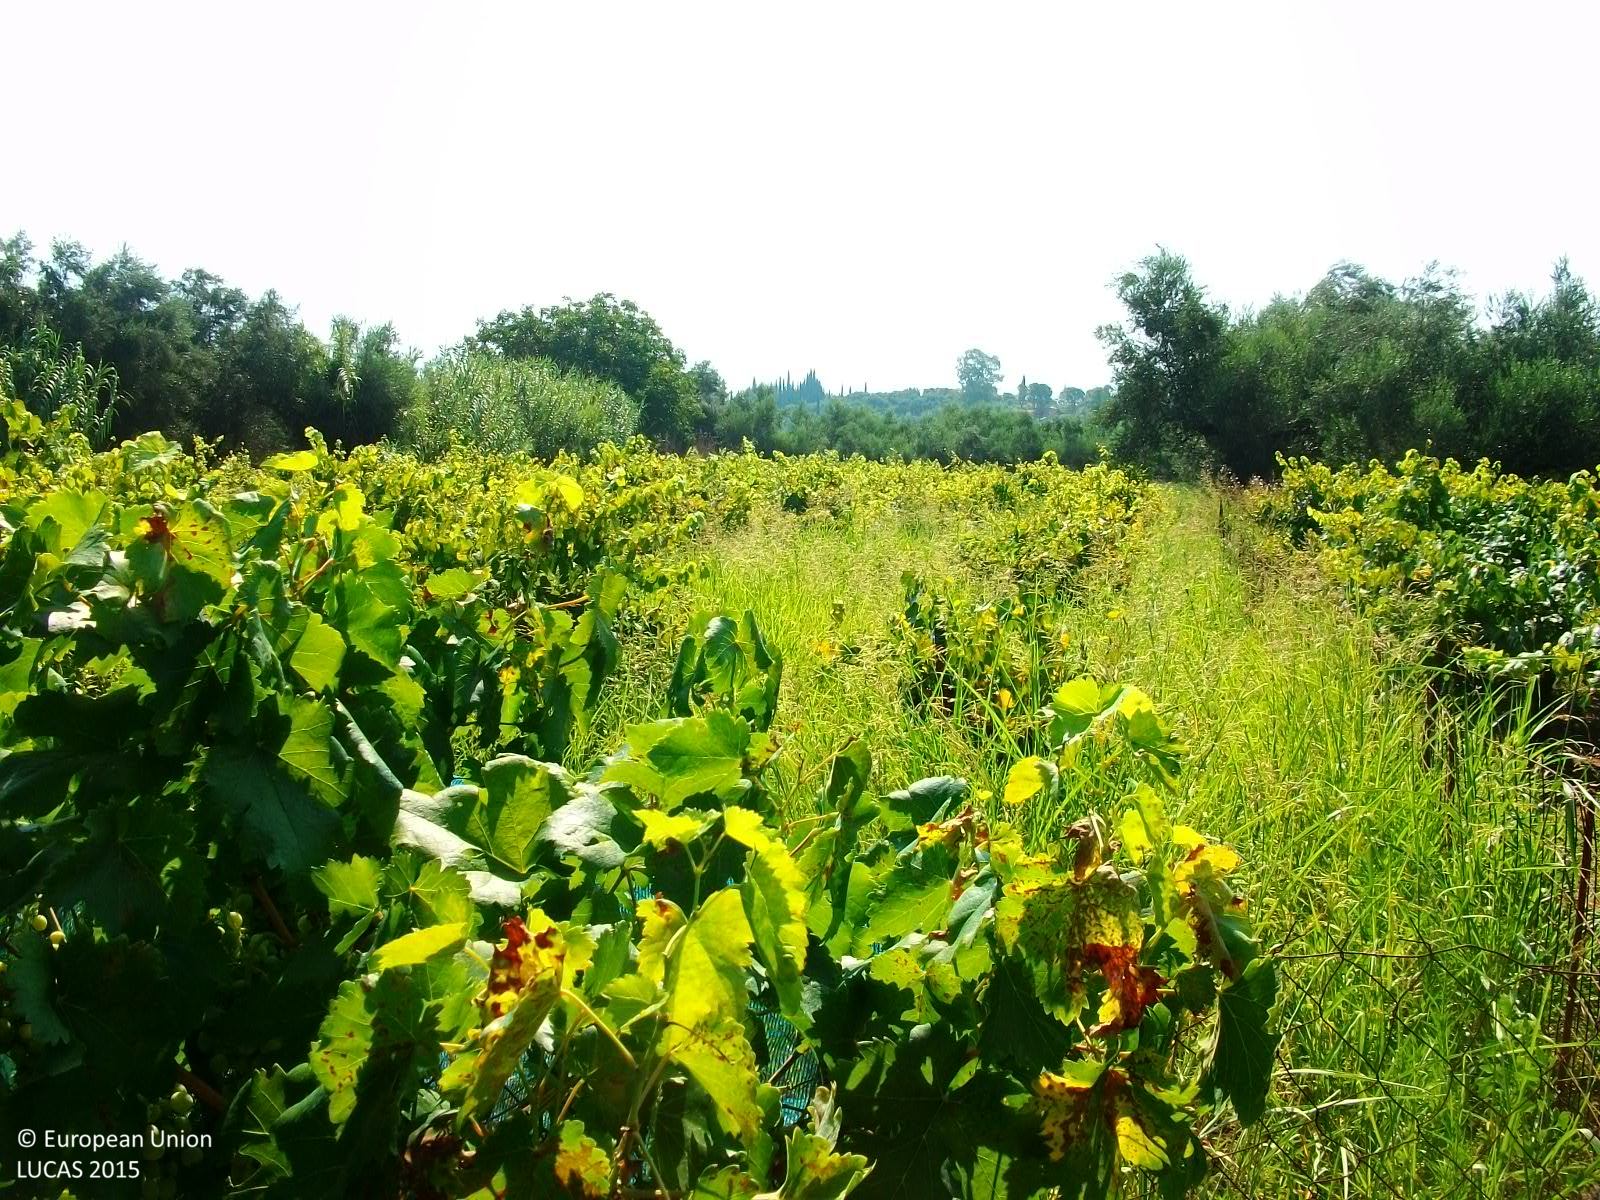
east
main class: Cropland
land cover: Olive groves
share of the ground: 25 - 50 %
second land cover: Spontaneously vegetated surfaces
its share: > 75 %
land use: Agriculture (excluding fallow land and kitchen gardens)
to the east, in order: Olive groves; Spontaneously vegetated surfaces; Fences; Vineyards; Grass margins; Rivers and streams; Shruby margins; Olive groves; Grass margins; Paved roads, cycling and walking lanes; Grass margins; Ditches and canals; Olive groves; Inland marshes; Olive groves; Fences; Olive groves
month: July
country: GR
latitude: 37.1357
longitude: 21.9654
